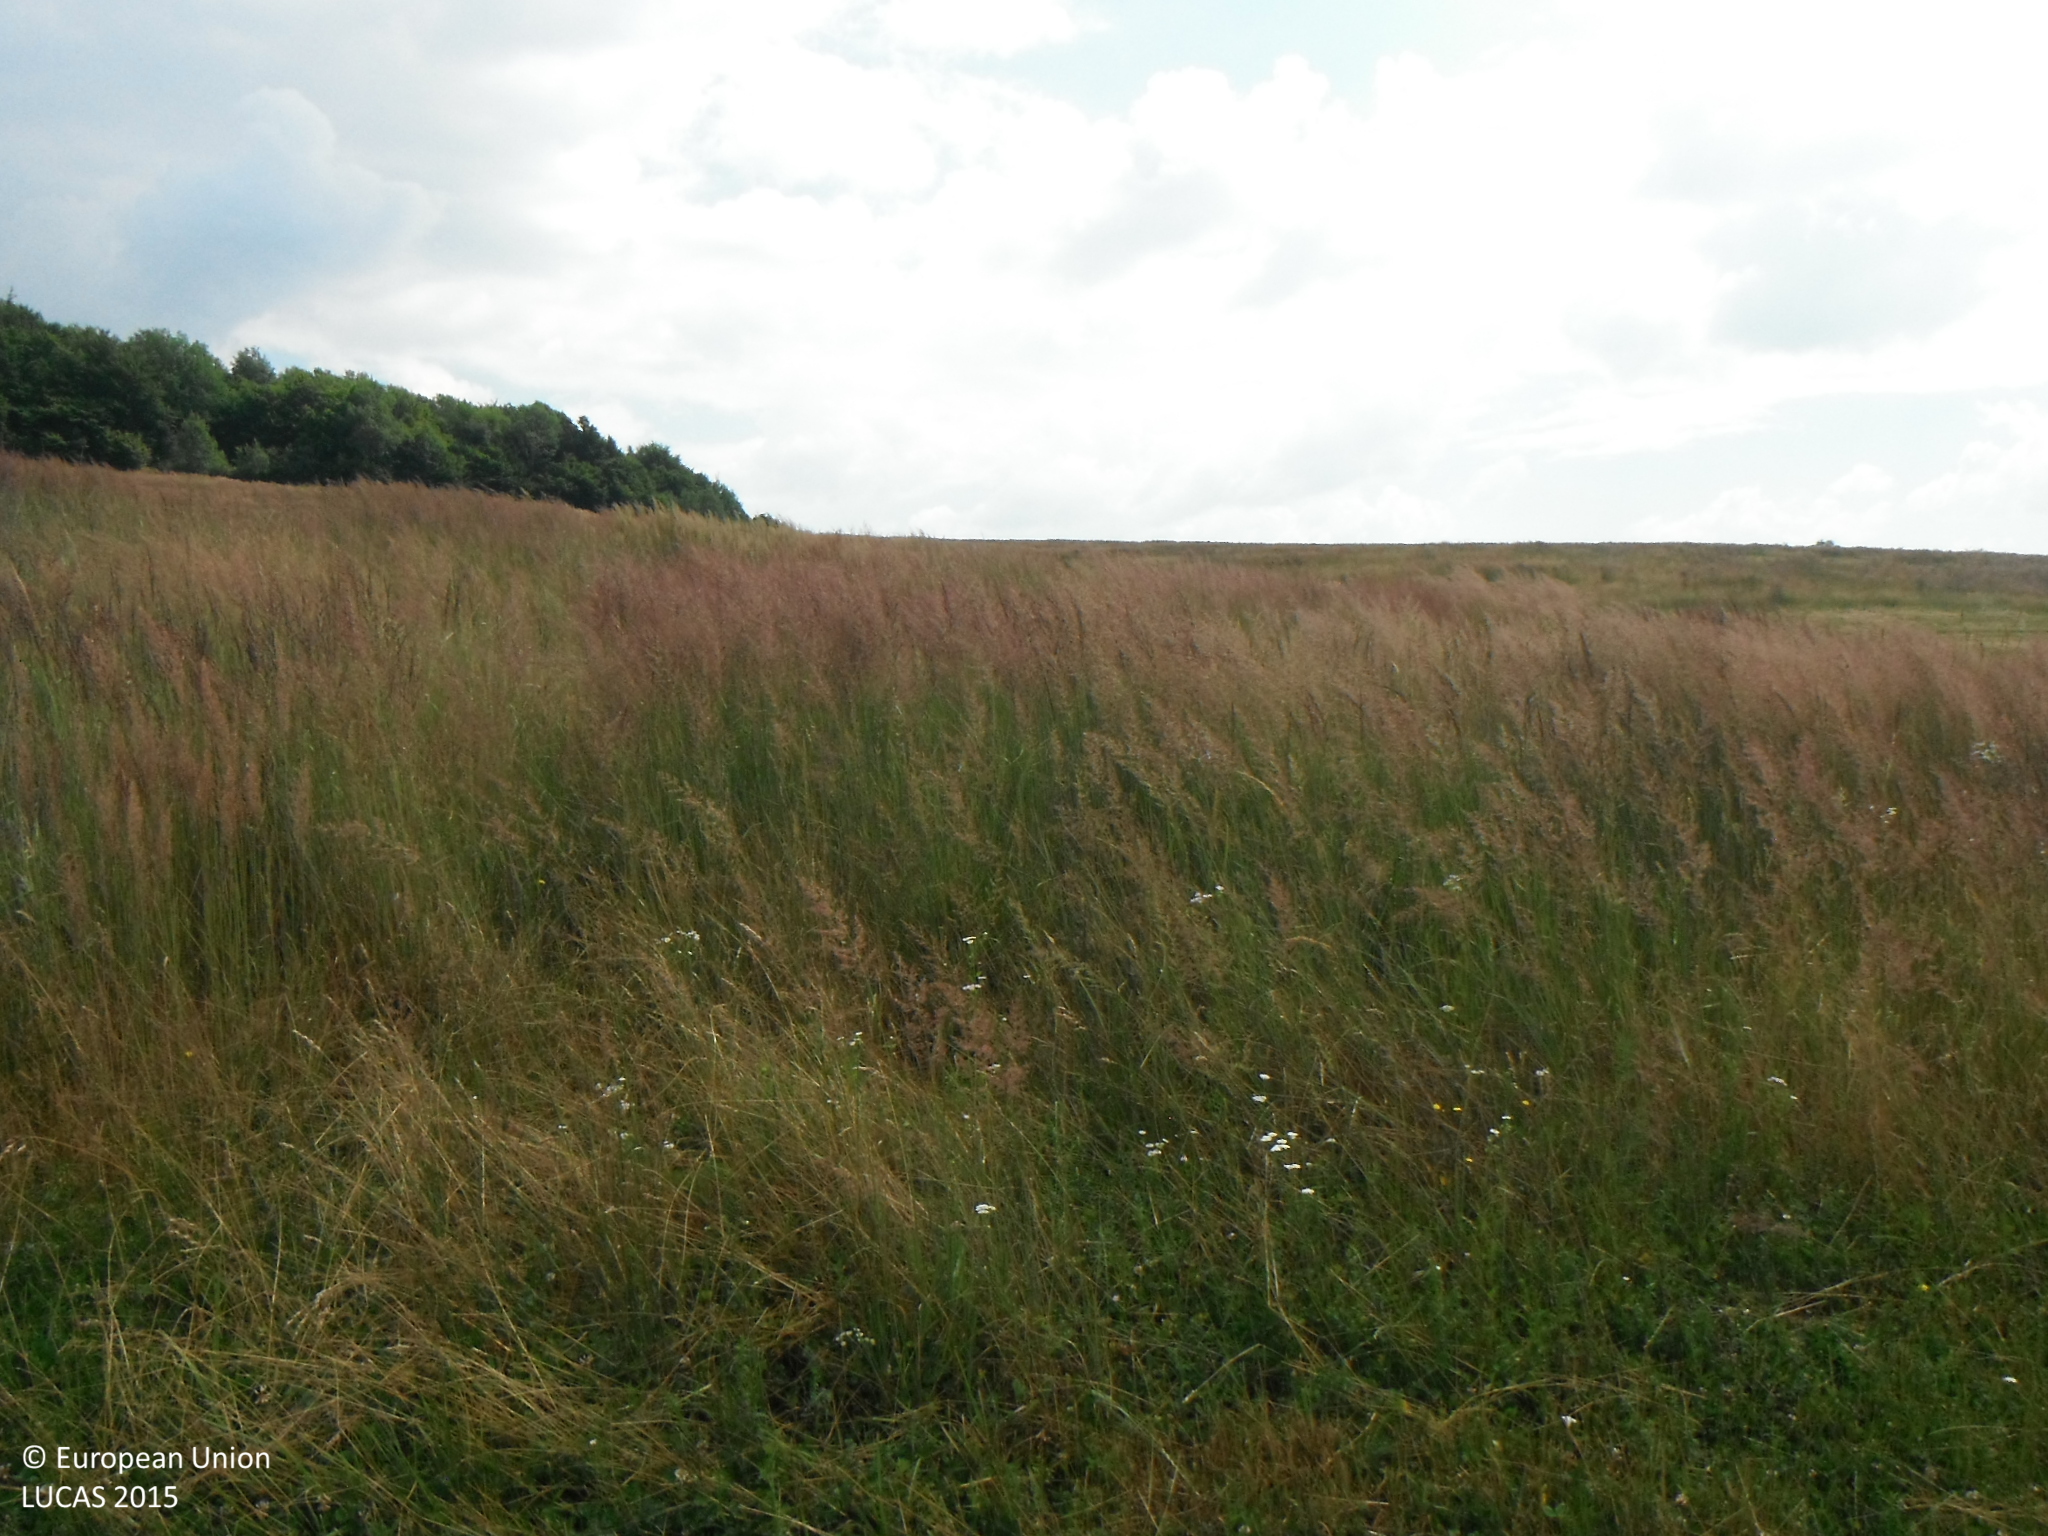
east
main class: Grassland
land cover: Grassland without tree/shrub cover
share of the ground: > 75 %
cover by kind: herbaceous plants 100 %
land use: Agriculture (excluding fallow land and kitchen gardens)
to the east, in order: Grassland without tree/shrub cover
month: June
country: SK
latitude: 48.5178
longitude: 19.9255
